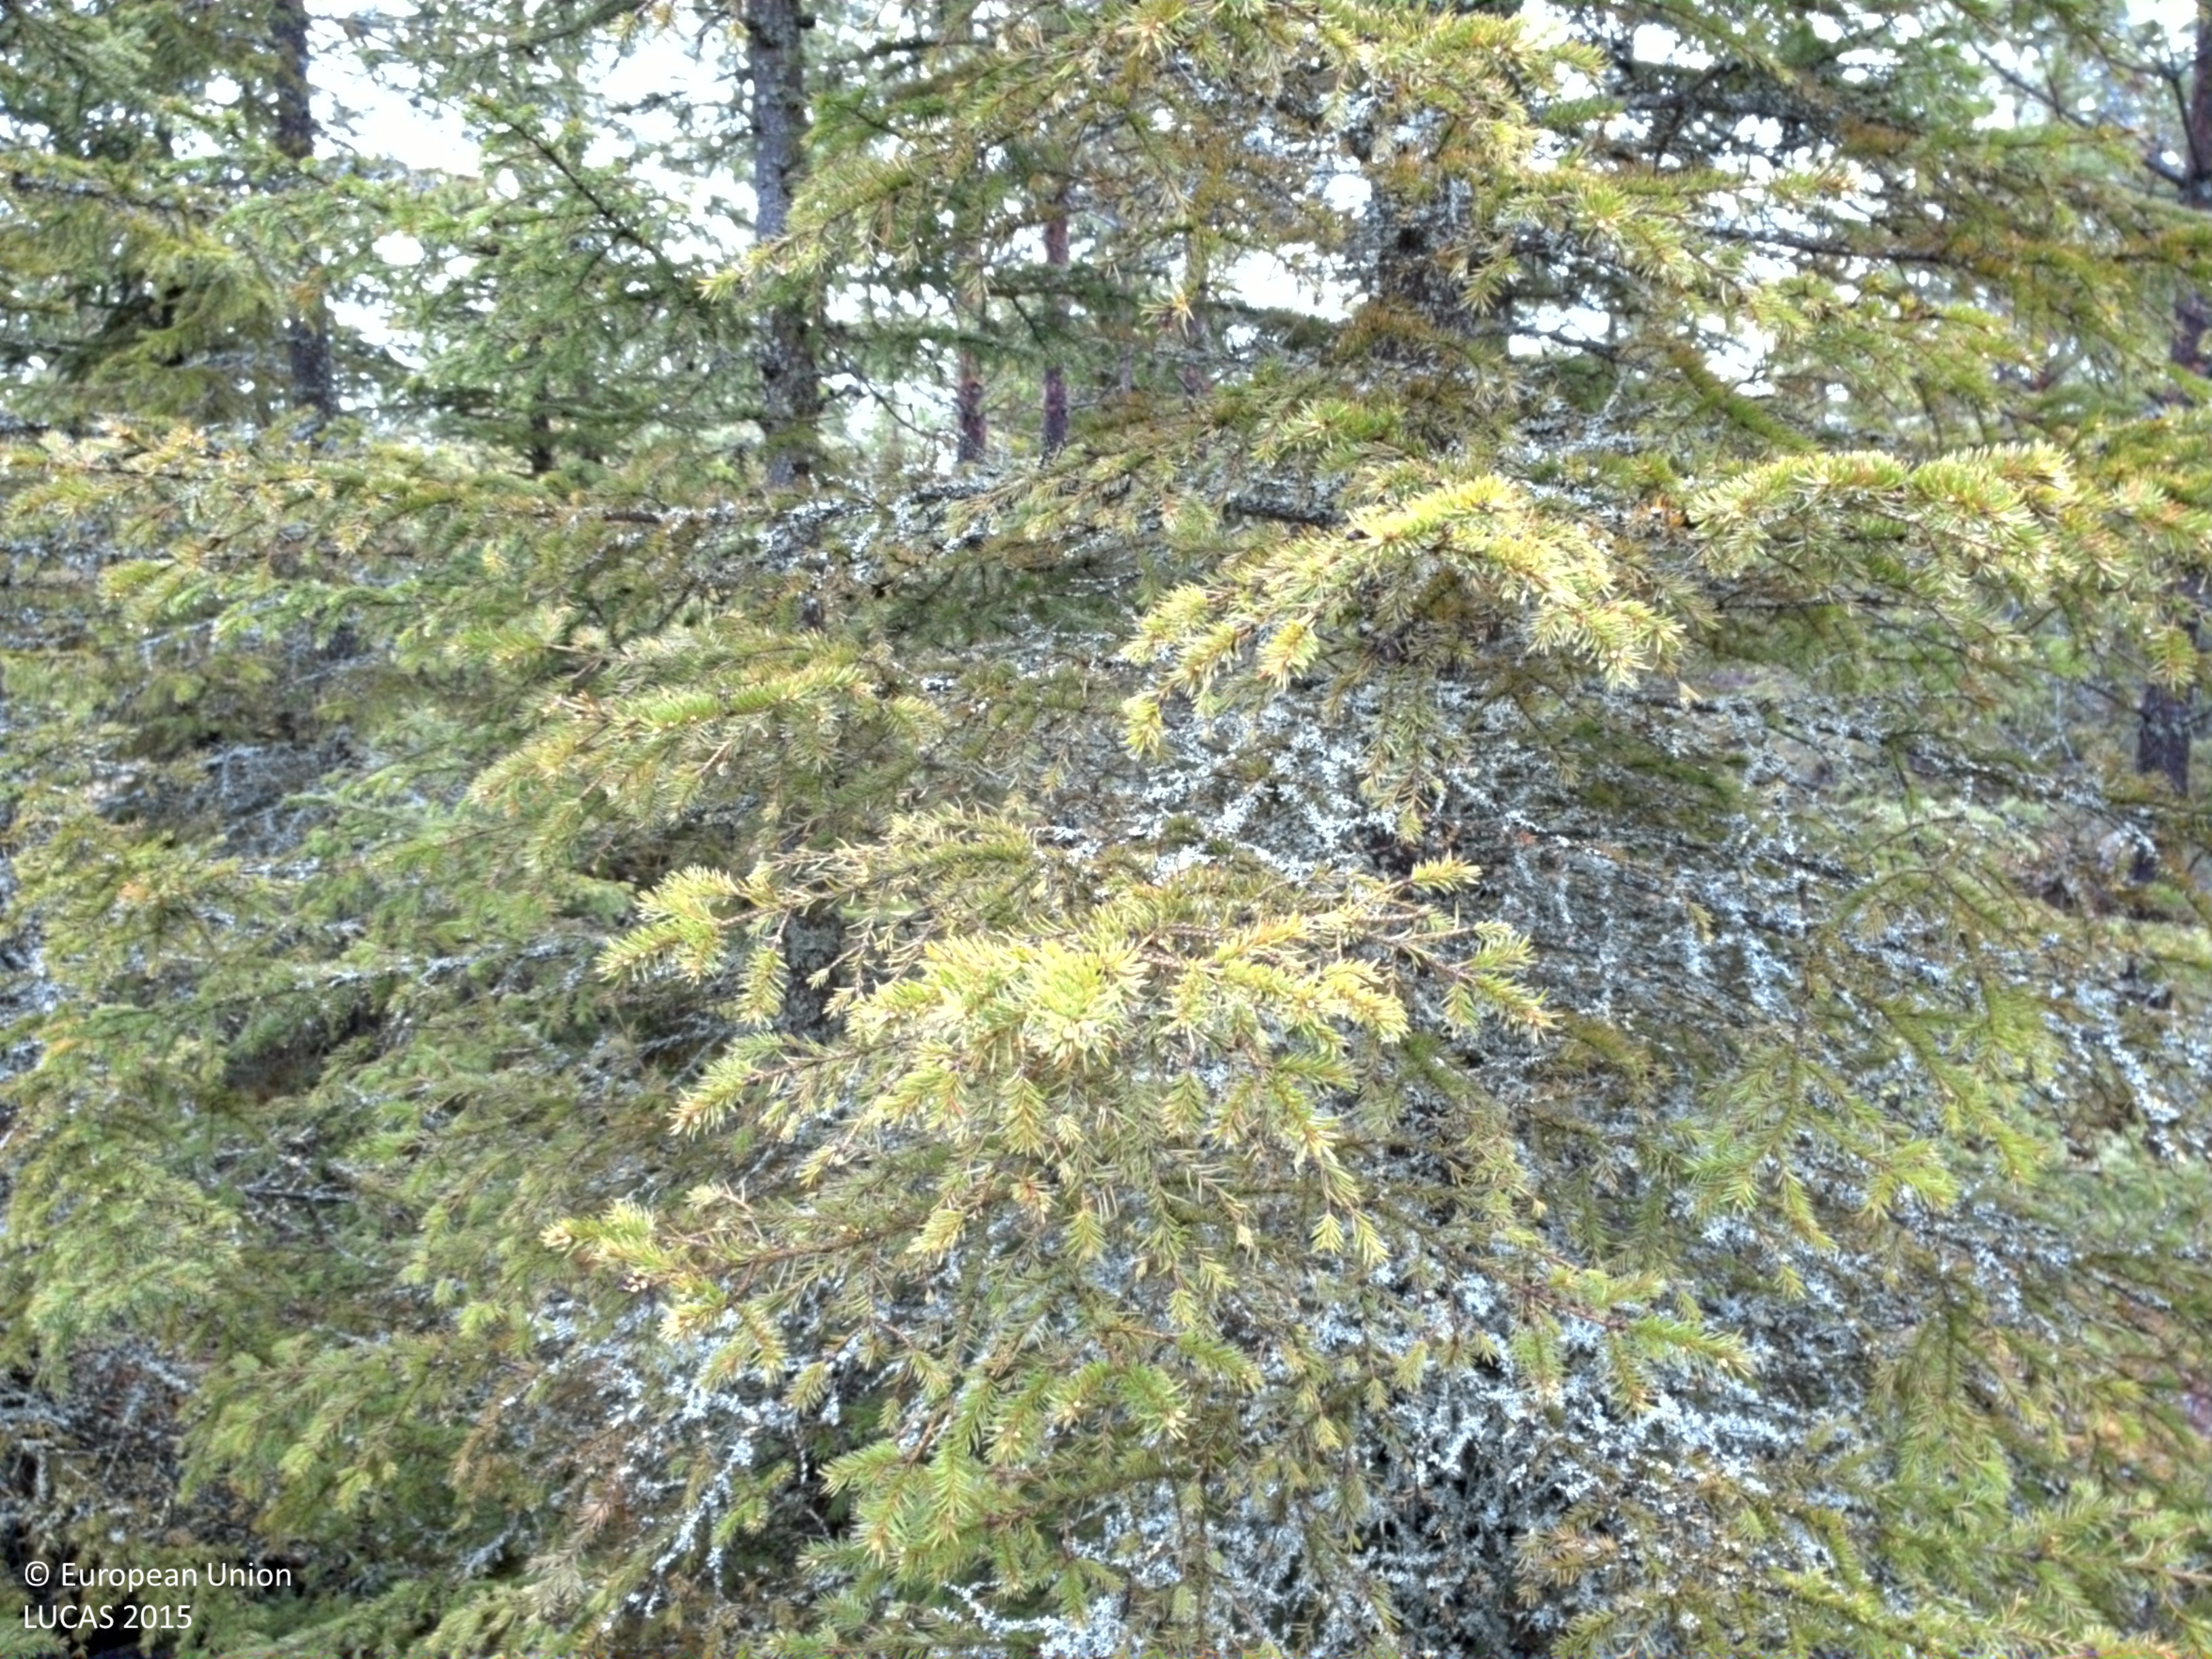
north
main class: Woodland
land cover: Spruce dominated coniferous woodland
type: boreal forest
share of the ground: 50 - 75 %
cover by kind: coniferous forest trees 70 %, shrubs 25 %, broadleaved forest trees 5 %
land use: Forestry
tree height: > 5 m
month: May
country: SE
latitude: 66.3070
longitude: 23.2076
